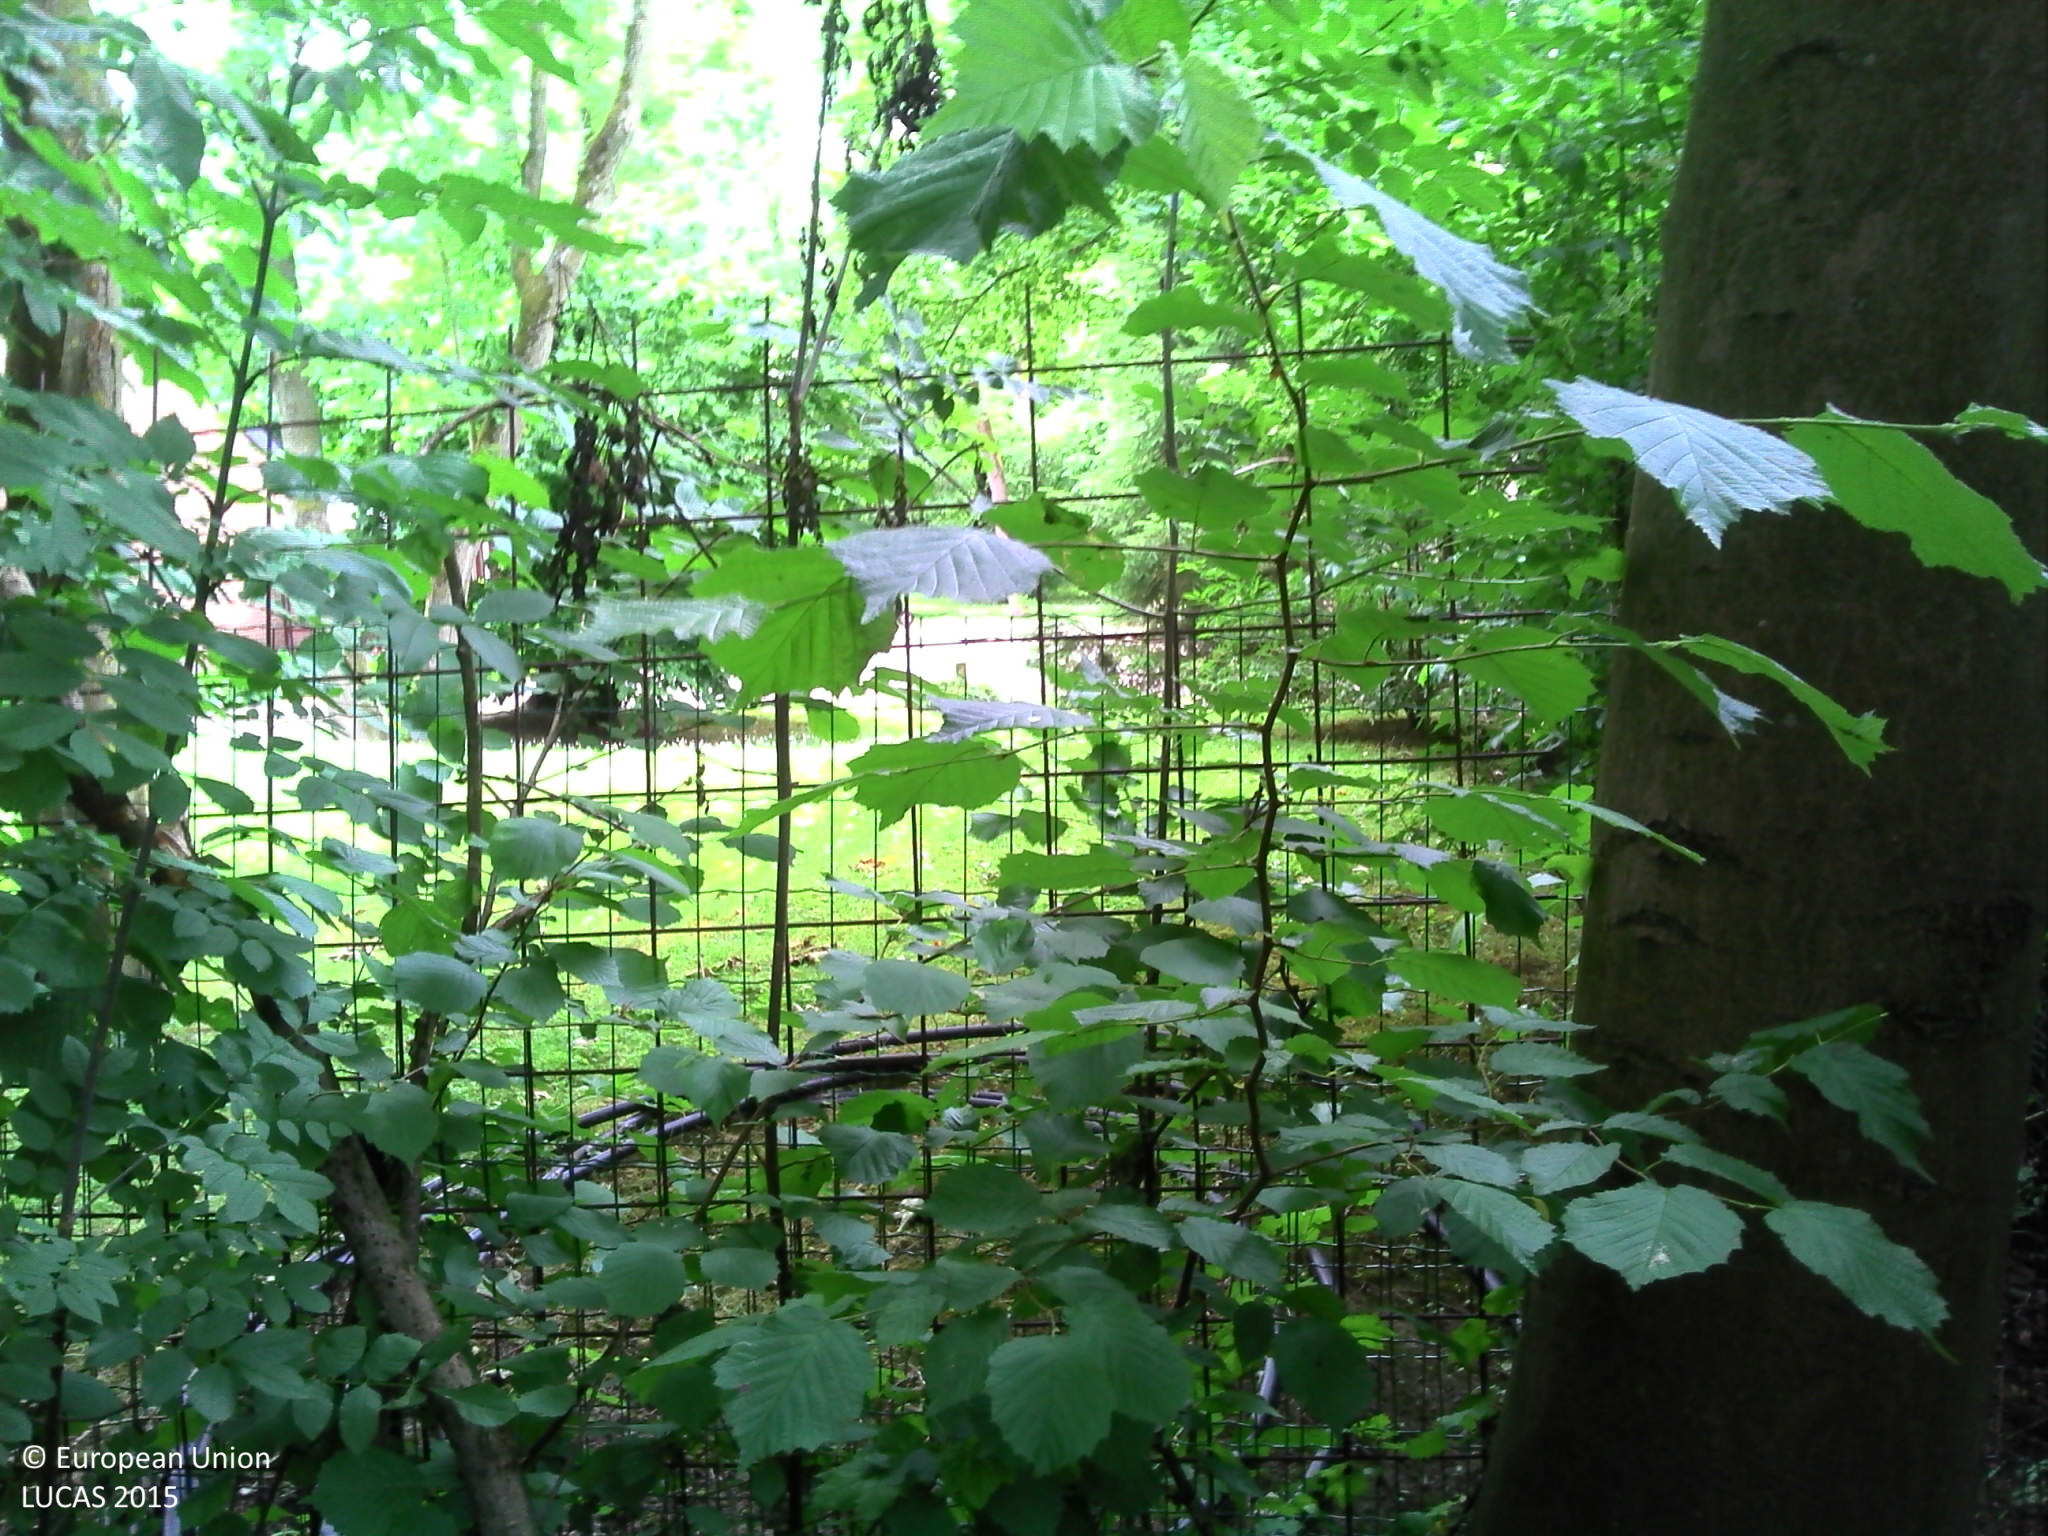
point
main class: Grassland
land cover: Grassland with sparse tree/shrub cover
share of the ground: > 75 %
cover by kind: herbaceous plants 95 %, broadleaved forest trees 5 %
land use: Residential
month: June
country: BE
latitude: 50.4206
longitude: 3.9560
